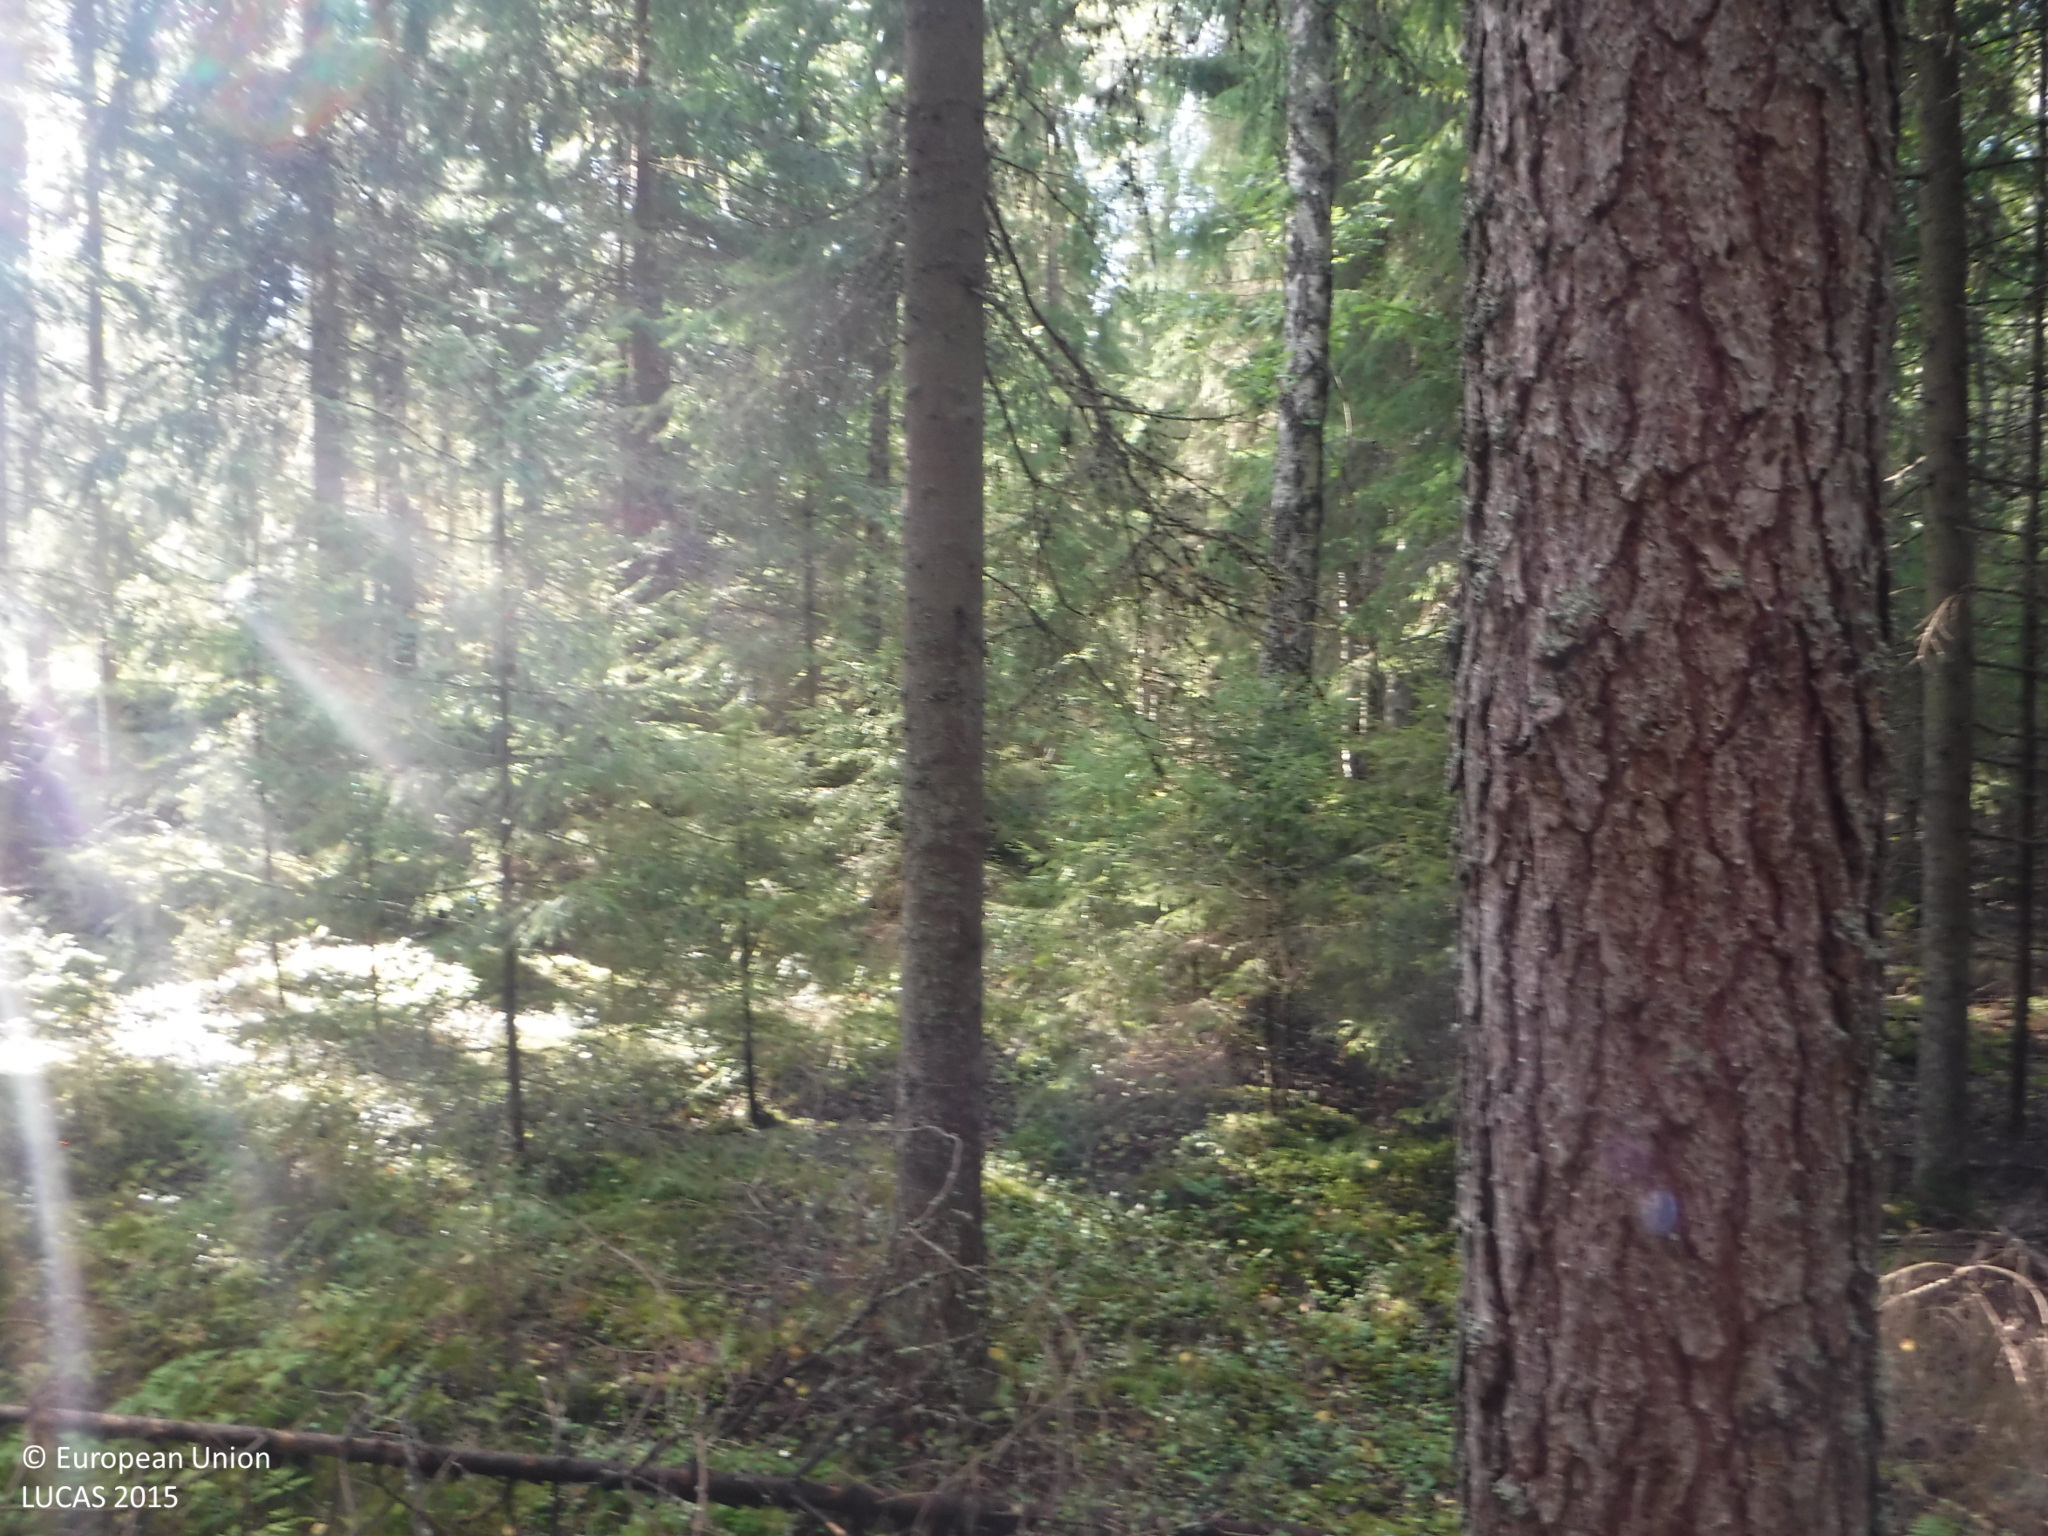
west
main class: Woodland
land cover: Other mixed woodland
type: boreal forest
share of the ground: > 75 %
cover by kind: coniferous forest trees 50 %, broadleaved forest trees 25 %, lichens and mosses 15 %, shrubs 10 %
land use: Forestry
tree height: > 5 m
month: September
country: FI
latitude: 61.4004
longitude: 23.0503
